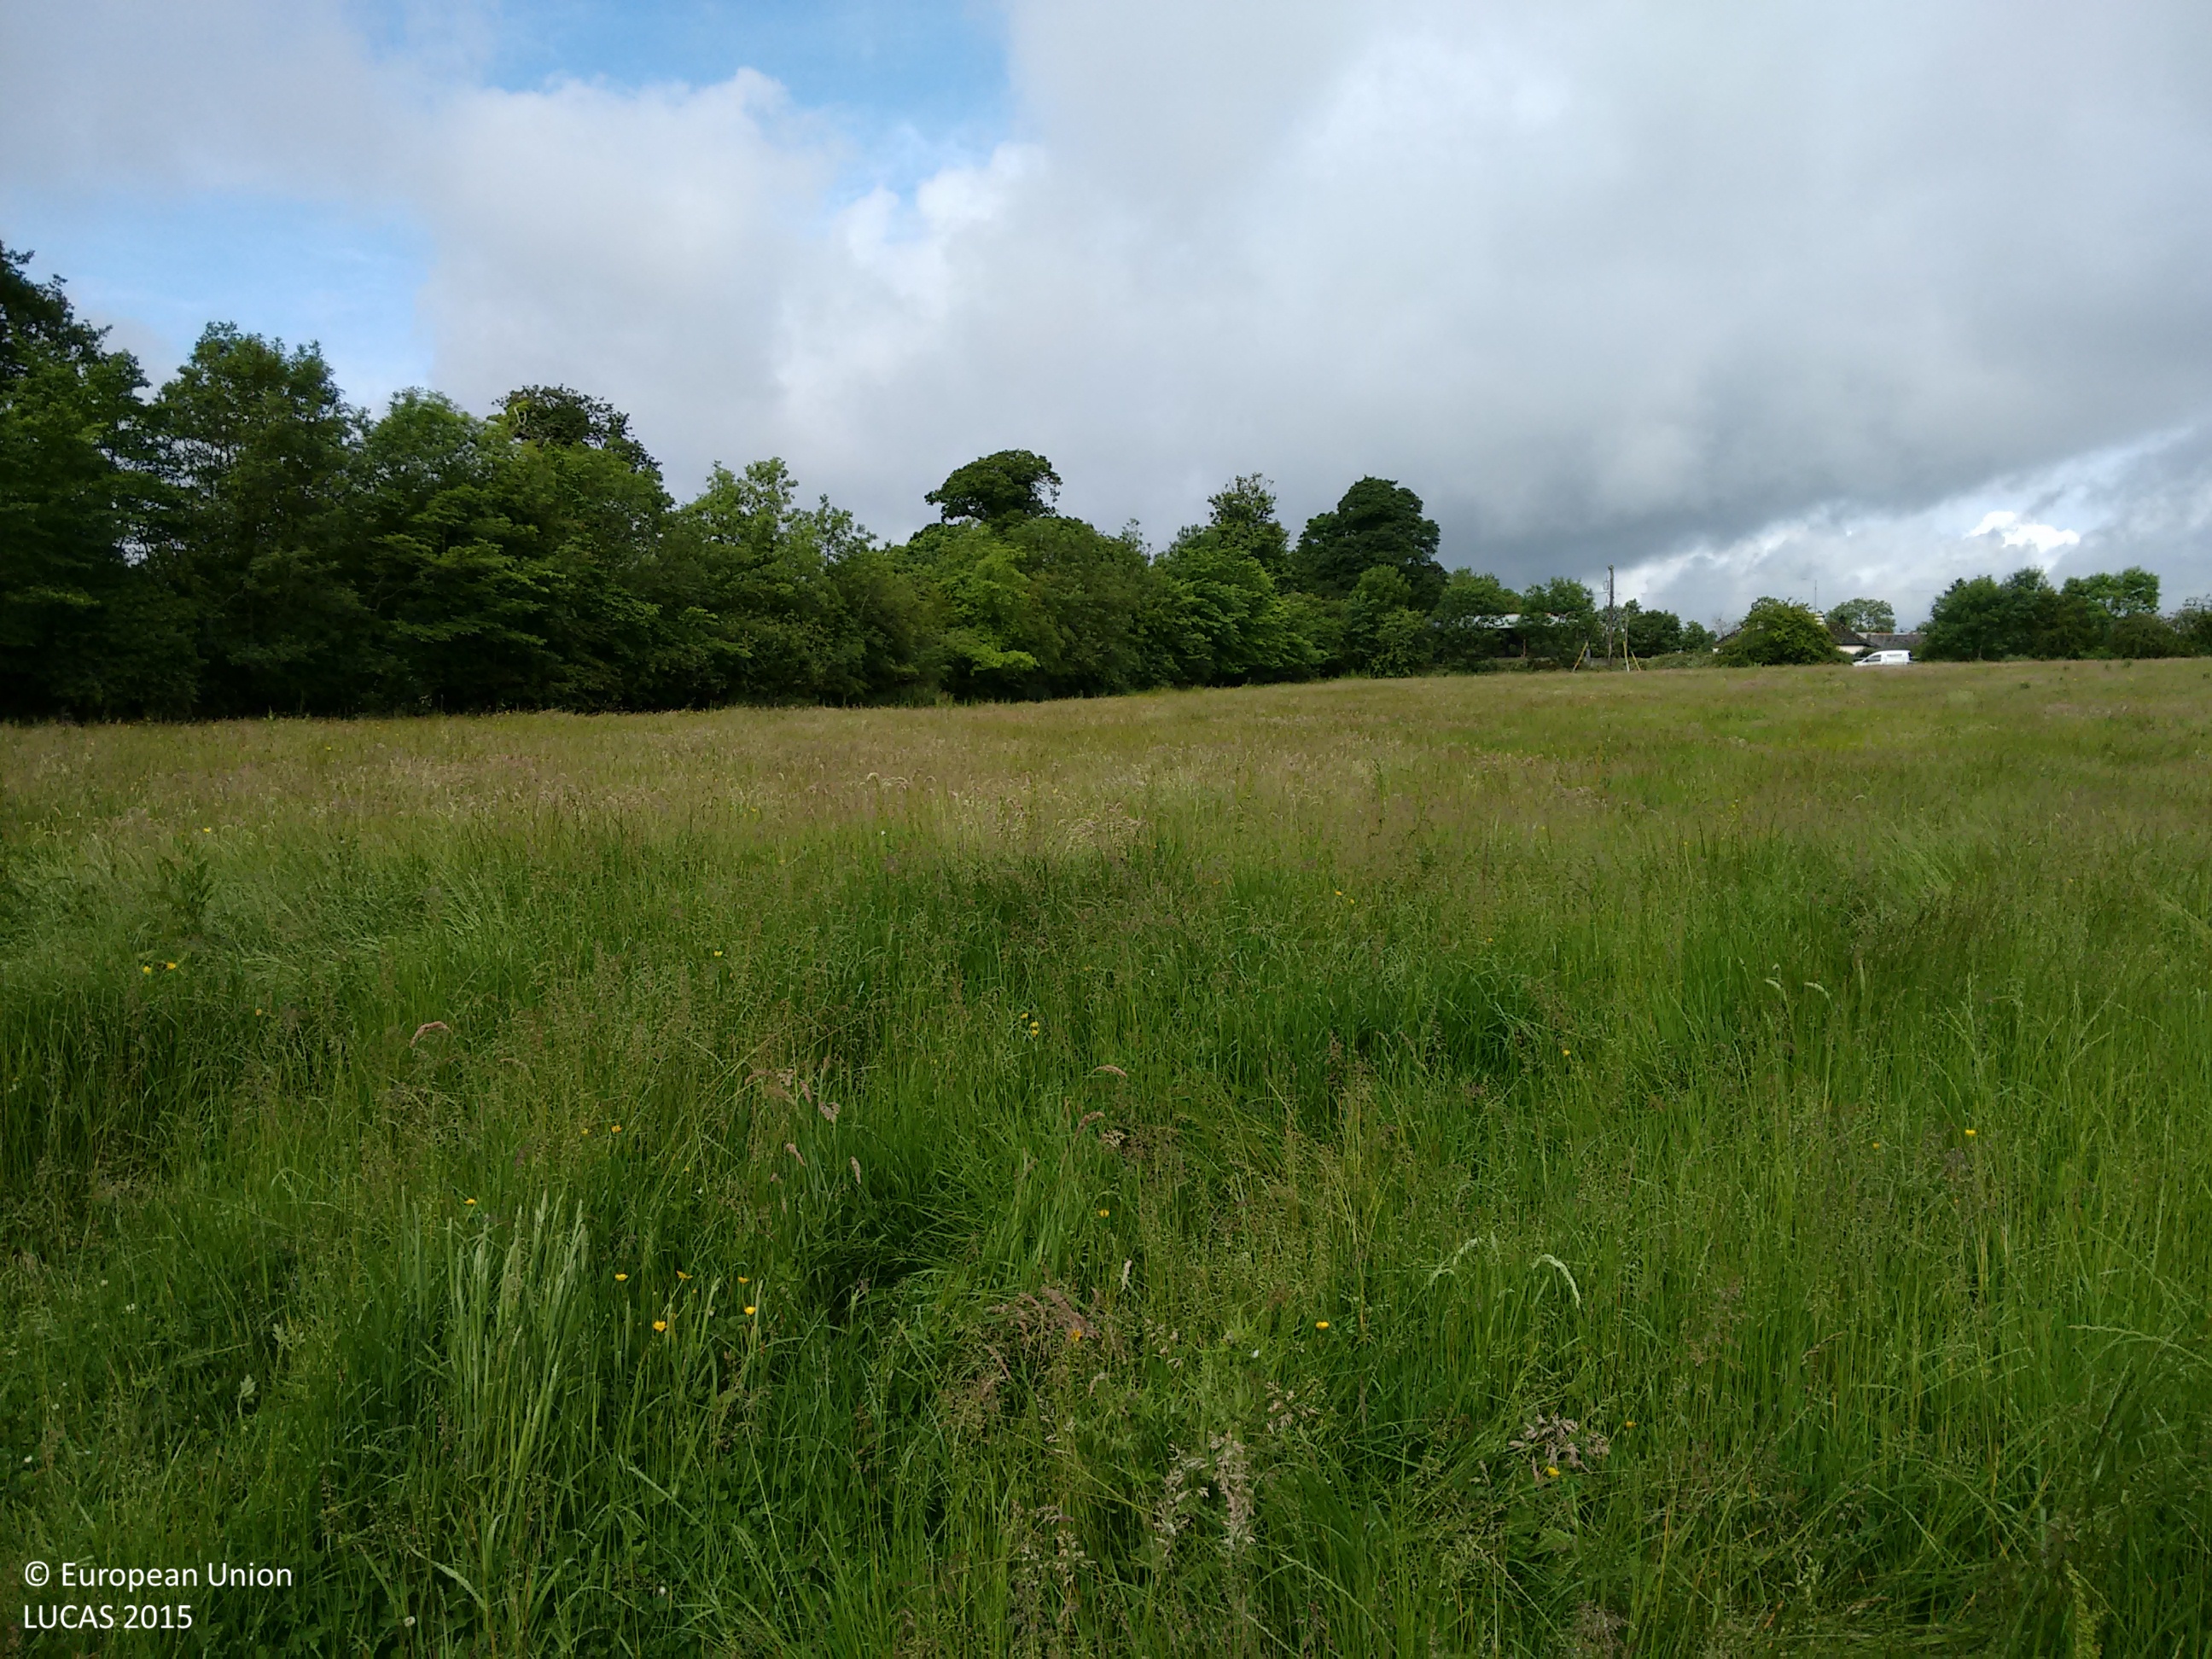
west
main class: Grassland
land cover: Grassland without tree/shrub cover
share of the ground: > 75 %
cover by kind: herbaceous plants 100 %
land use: Agriculture (excluding fallow land and kitchen gardens)
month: June
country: IE
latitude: 53.6556
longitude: -6.7632
